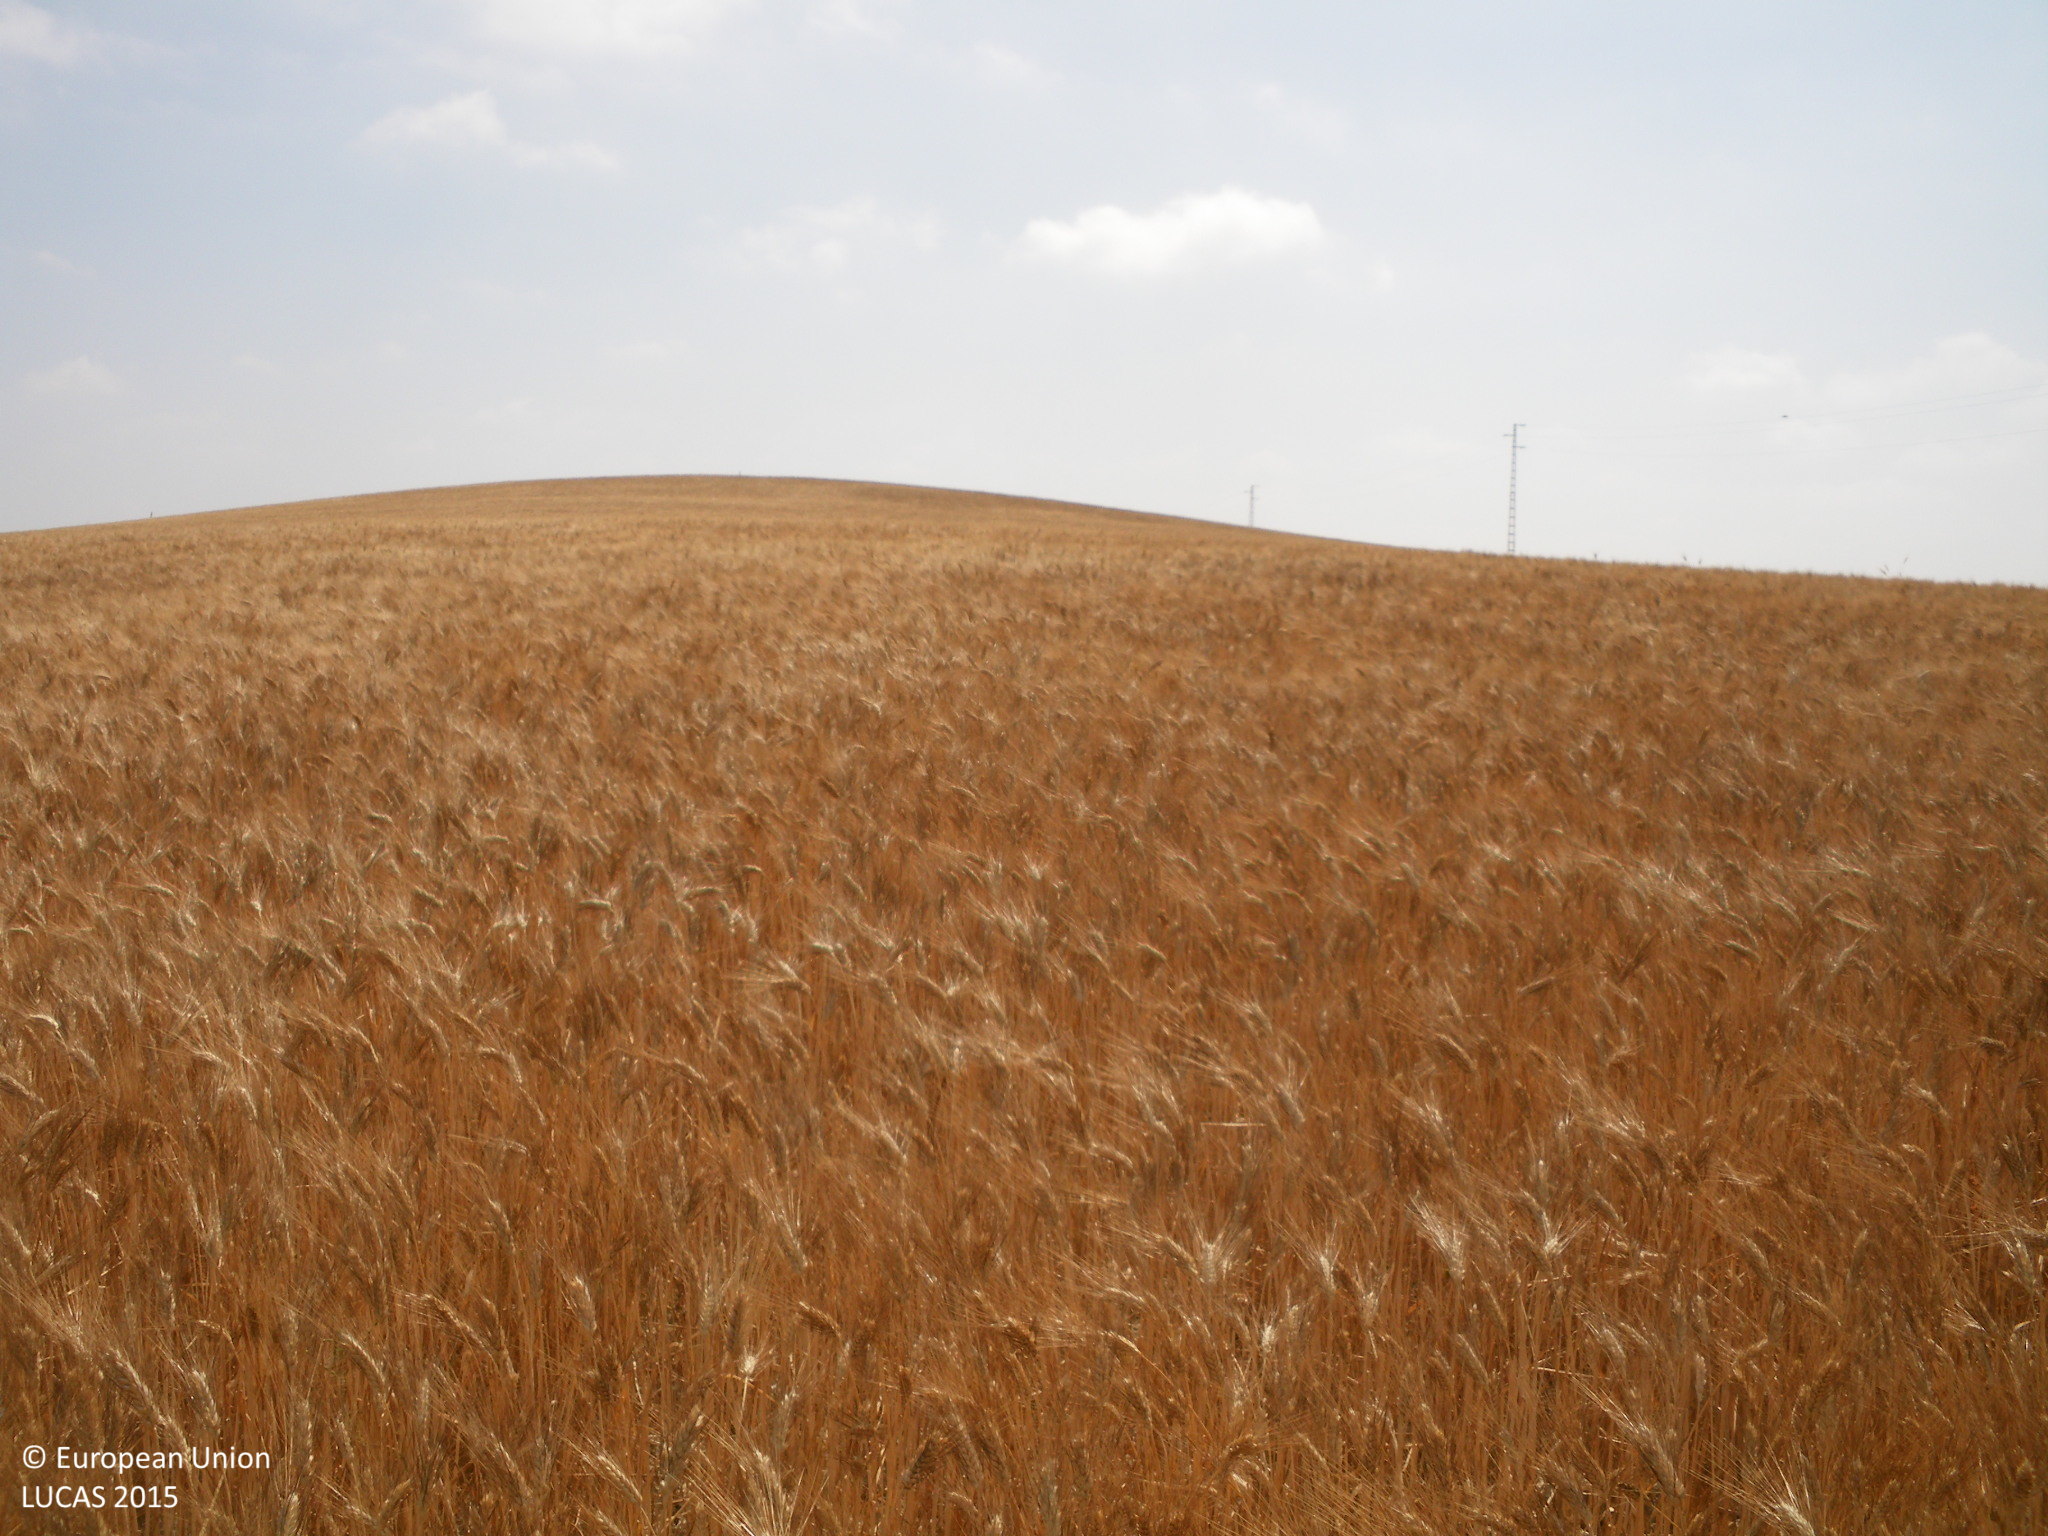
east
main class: Cropland
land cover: Durum wheat
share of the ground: > 75 %
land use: Agriculture (excluding fallow land and kitchen gardens)
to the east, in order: Durum wheat
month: May
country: ES
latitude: 36.8329
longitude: -6.1730
